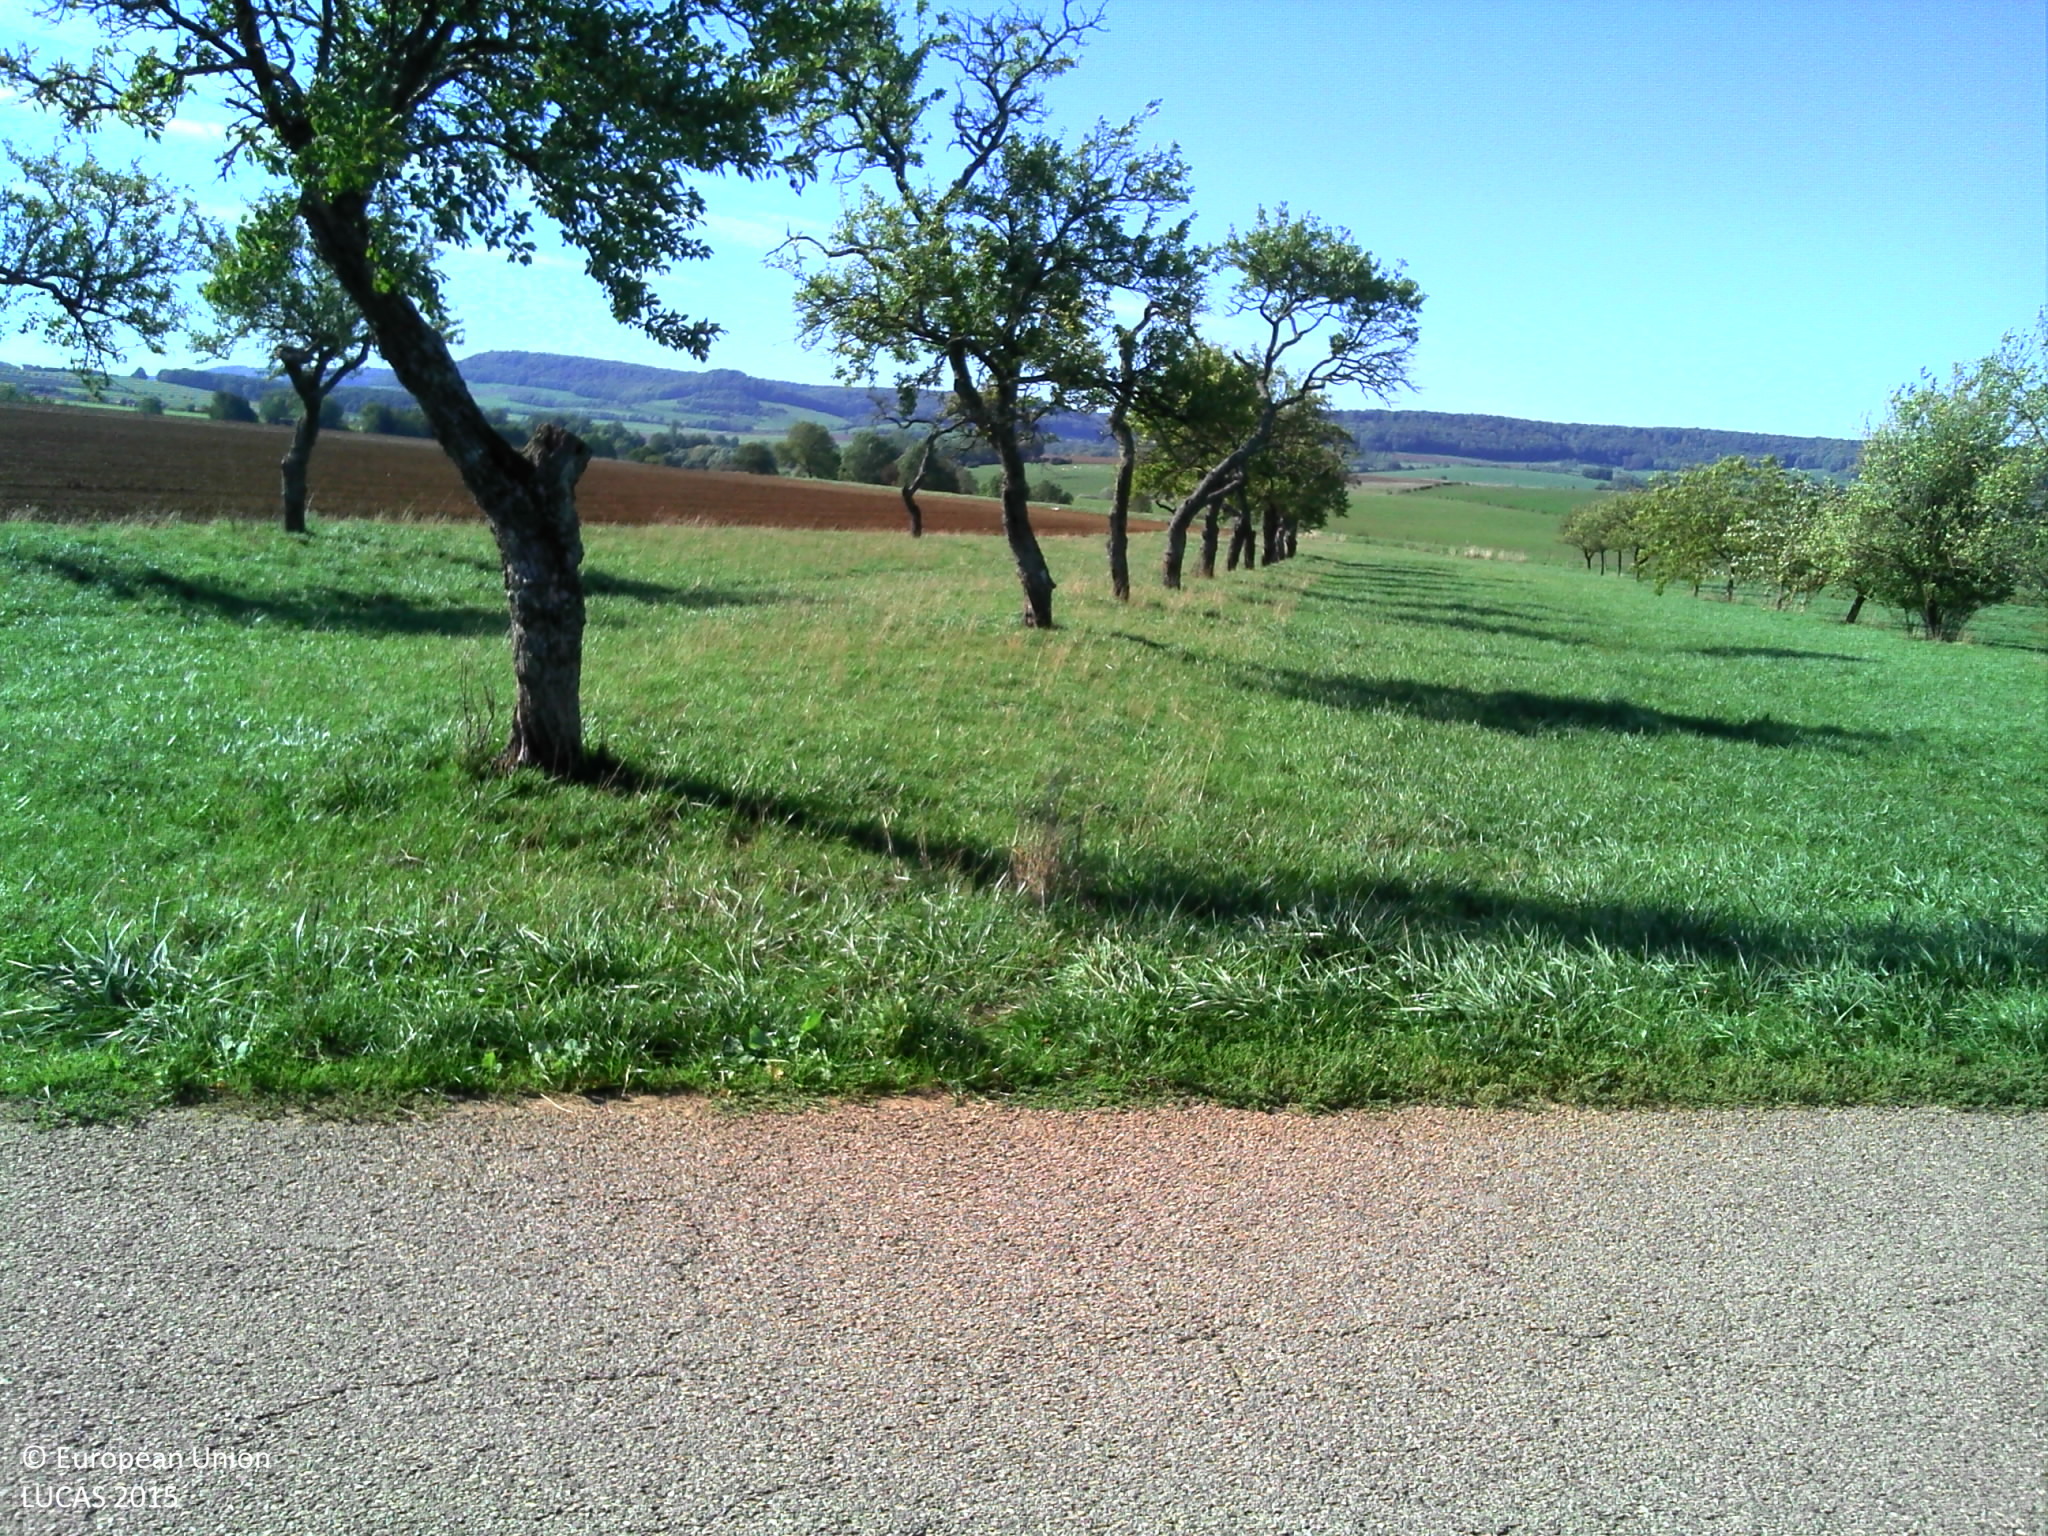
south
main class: Grassland
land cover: Grassland without tree/shrub cover
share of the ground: > 75 %
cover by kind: herbaceous plants 80 %, consolidated bare surface 20 %
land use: Road transport
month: September
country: FR
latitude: 48.4586
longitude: 6.0379
